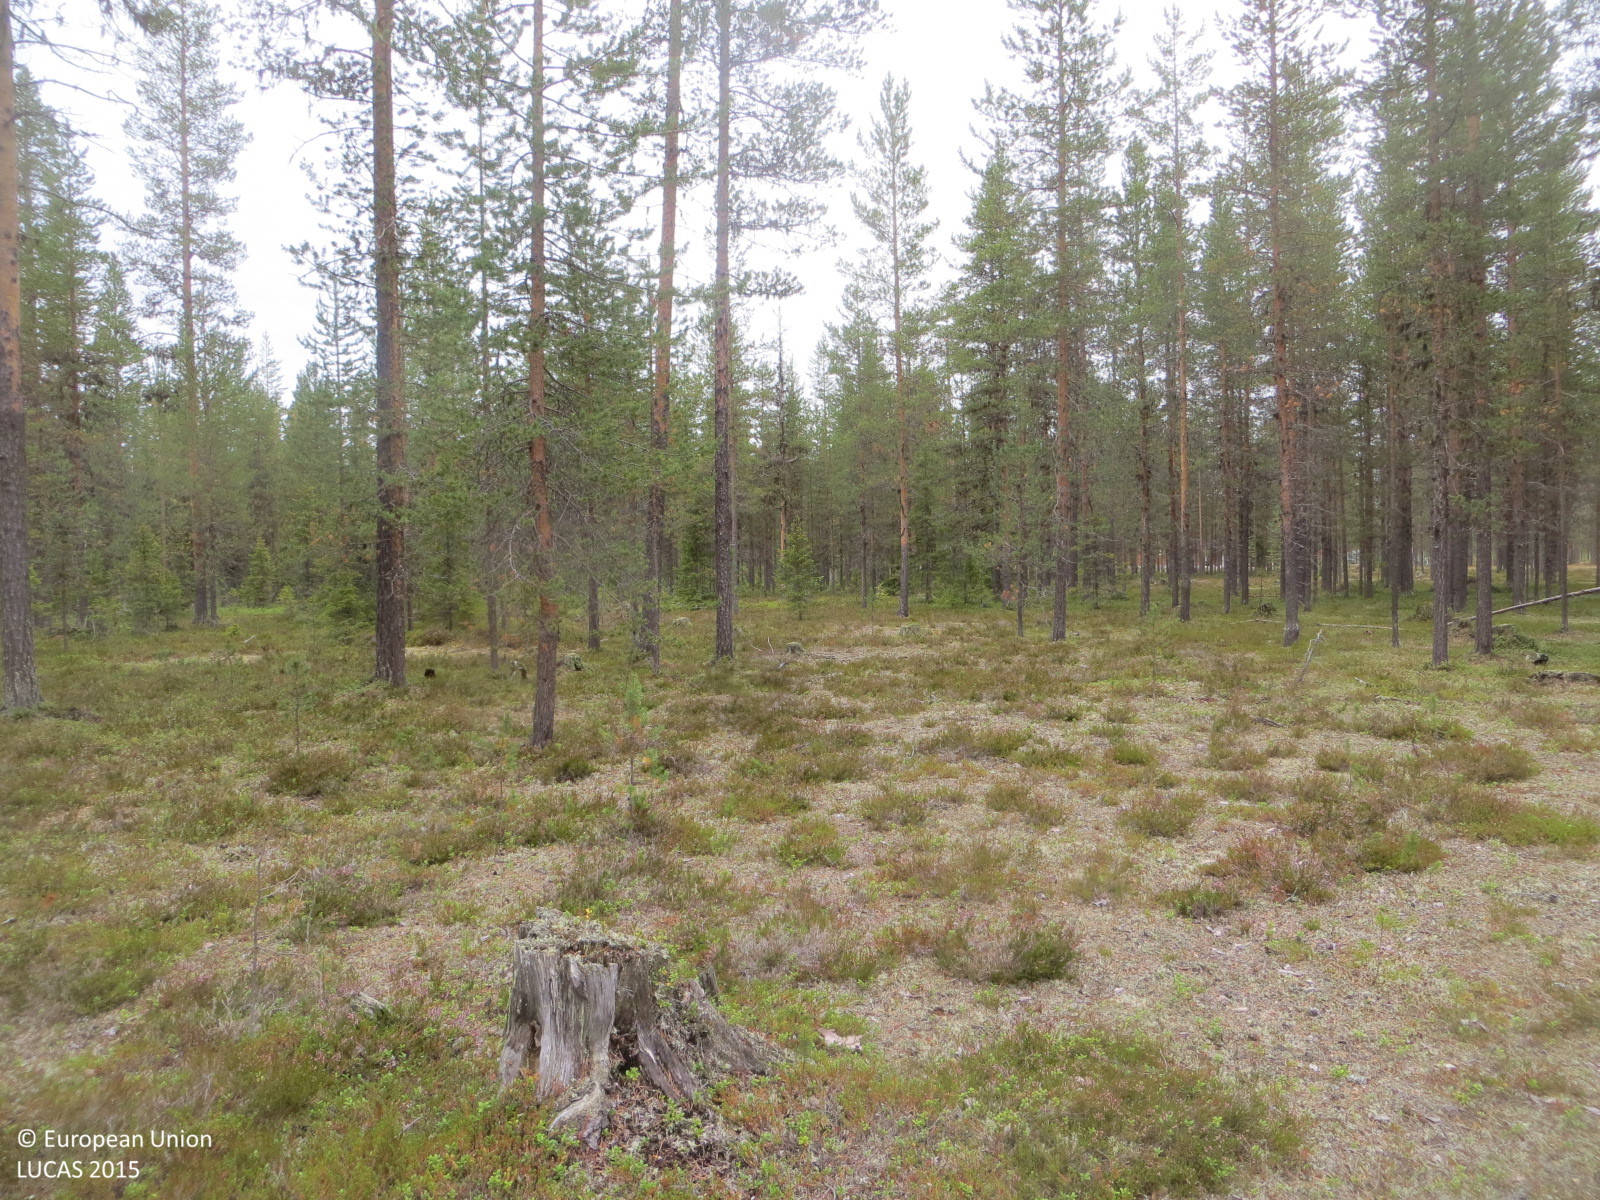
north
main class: Woodland
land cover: Pine dominated coniferous woodland
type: boreal forest
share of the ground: 25 - 50 %
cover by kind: shrubs 55 %, coniferous forest trees 45 %
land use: Forestry
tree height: > 5 m
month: August
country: FI
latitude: 67.4588
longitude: 24.2634
